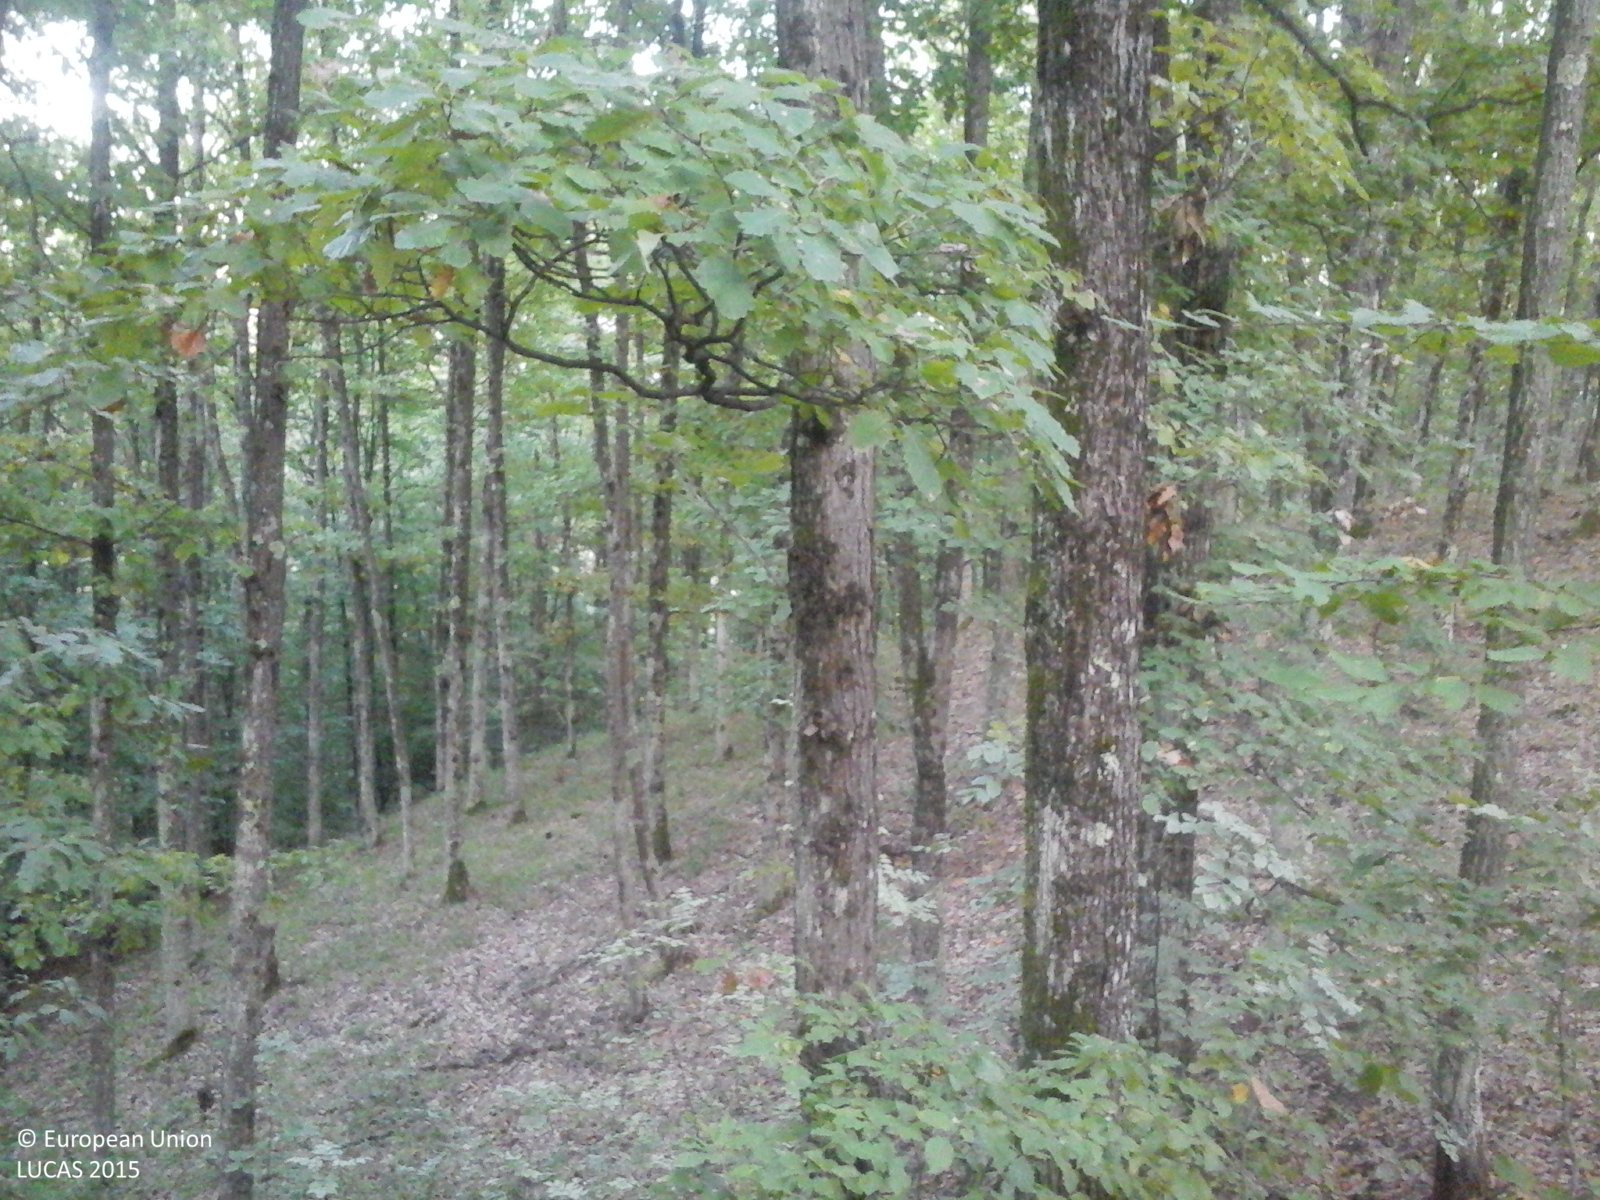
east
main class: Woodland
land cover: Broadleaved woodland
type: acidophilous oak and oak-birch forest
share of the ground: > 75 %
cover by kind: broadleaved forest trees 100 %
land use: Forestry
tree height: > 5 m
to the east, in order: Broadleaved woodland; Ditches and canals; Broadleaved woodland; Grassland without tree/shrub cover; Electric lines; Grassland without tree/shrub cover; Electric lines; Grassland without tree/shrub cover
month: September
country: RO
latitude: 44.9025
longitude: 23.3904
